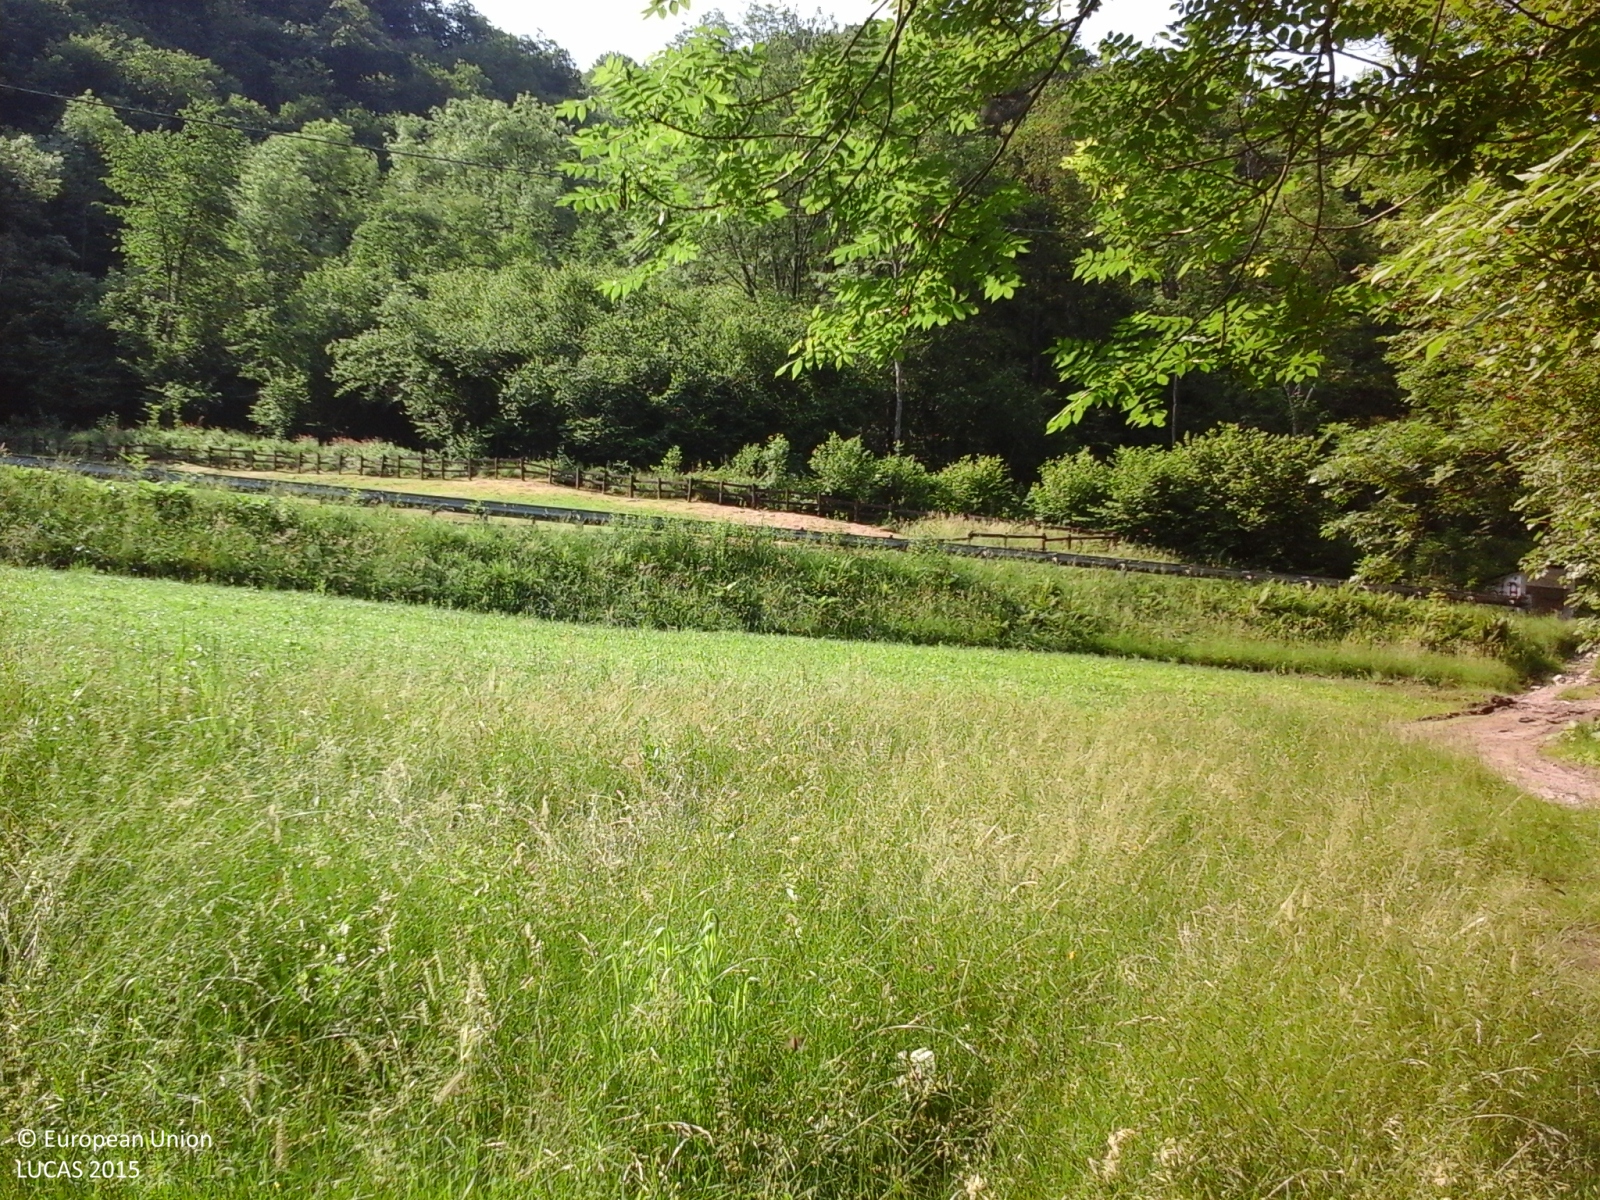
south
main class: Grassland
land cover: Grassland without tree/shrub cover
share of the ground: > 75 %
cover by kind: herbaceous plants 100 %
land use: Agriculture (excluding fallow land and kitchen gardens)
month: June
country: IT
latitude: 45.8162
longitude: 8.3680
